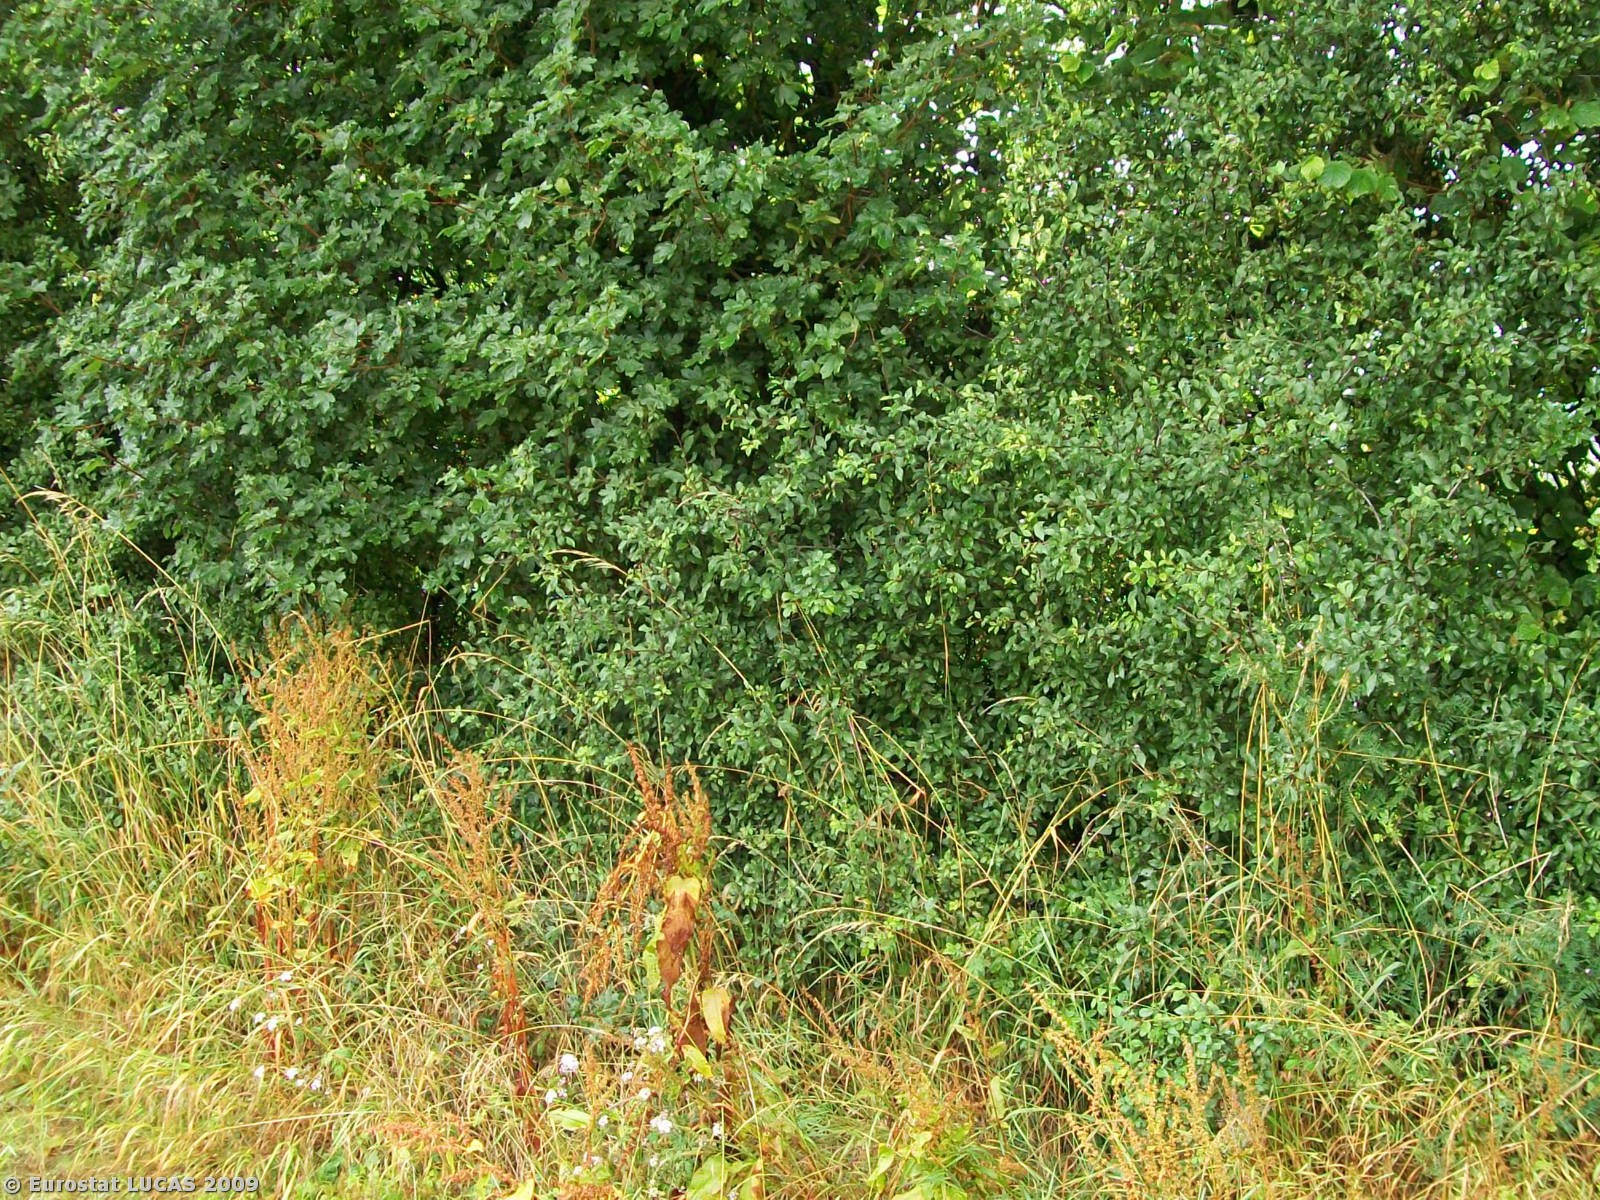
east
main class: Cropland
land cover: Dry pulses
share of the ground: > 75 %
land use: Agriculture (excluding fallow land and kitchen gardens)
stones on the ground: < 10 %
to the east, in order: Dry pulses; Grassland without tree/shrub cover; Managed hedges; Broadleaved woodland; Fences; Grassland without tree/shrub cover; Fences; Broadleaved woodland
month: July
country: GB
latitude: 51.5080
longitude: -2.2077
